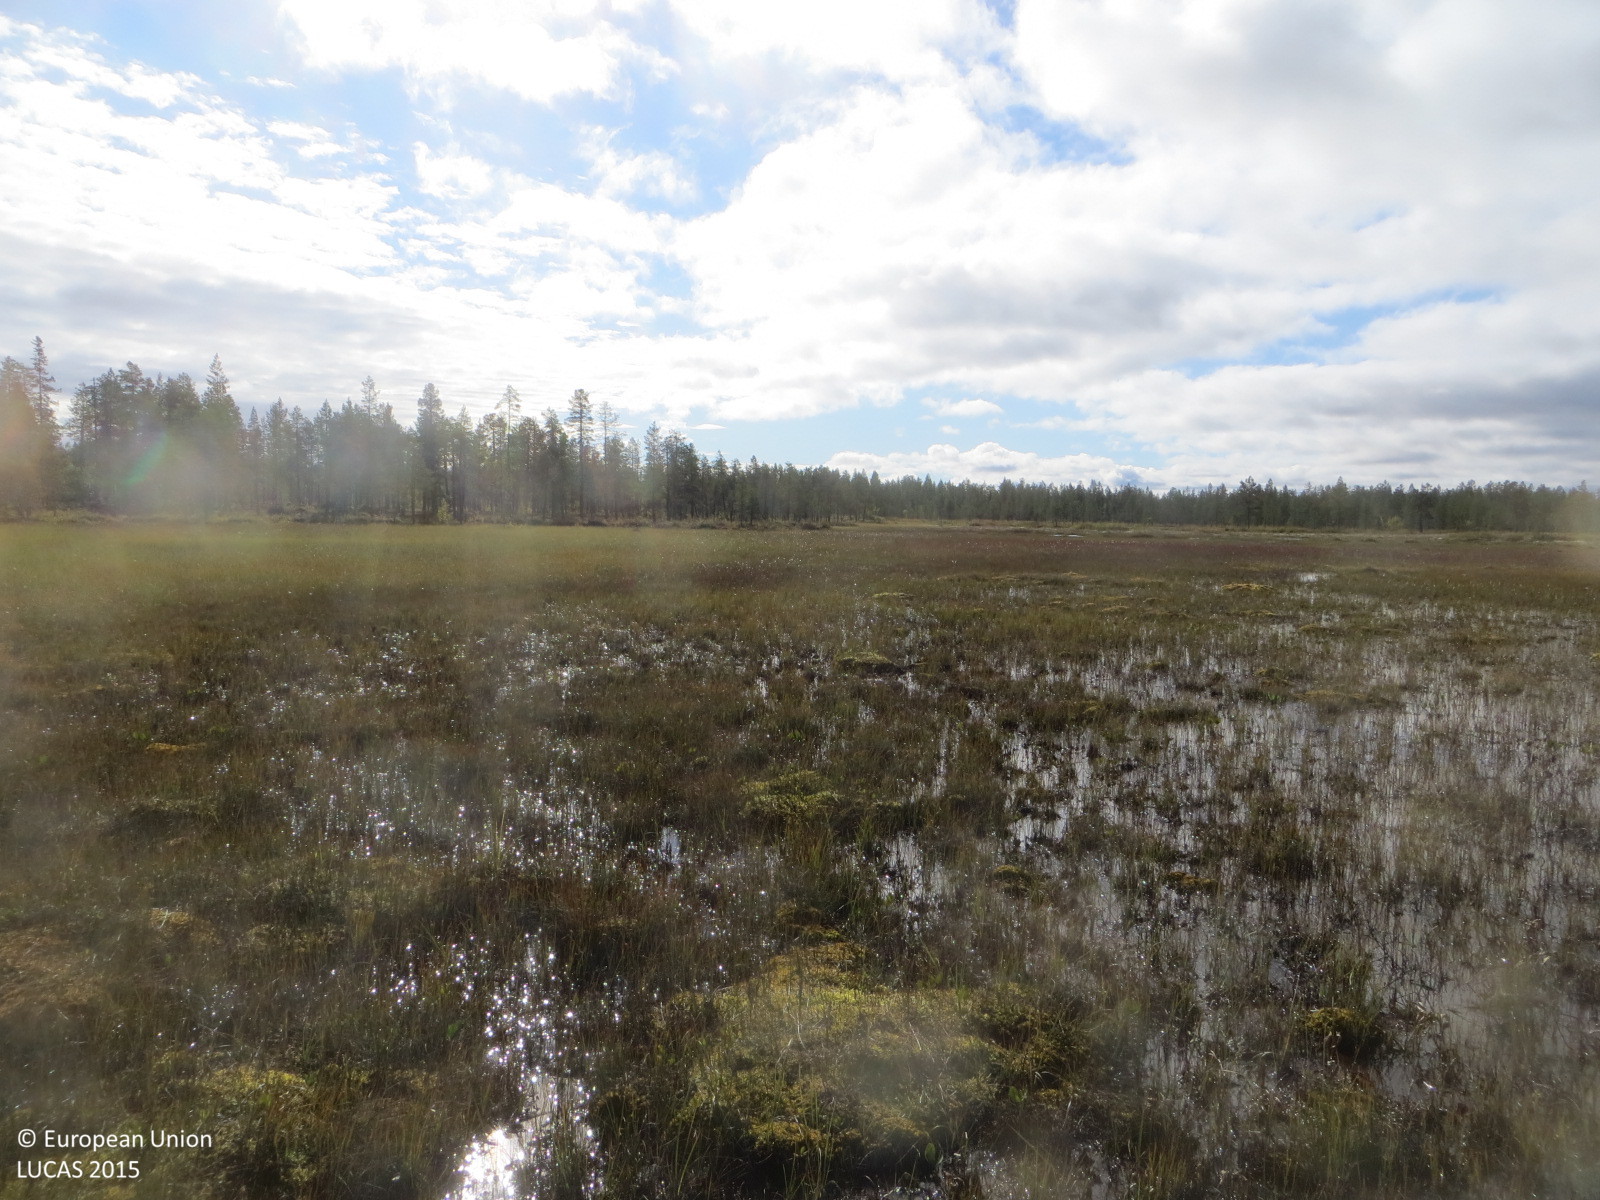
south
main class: Woodland
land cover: Pine dominated coniferous woodland
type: mire and swamp forests
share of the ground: 50 - 75 %
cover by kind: coniferous forest trees 50 %, shrubs 50 %
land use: Semi-natural and natural areas not in use
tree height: > 5 m
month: September
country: FI
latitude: 68.1527
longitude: 24.8355
